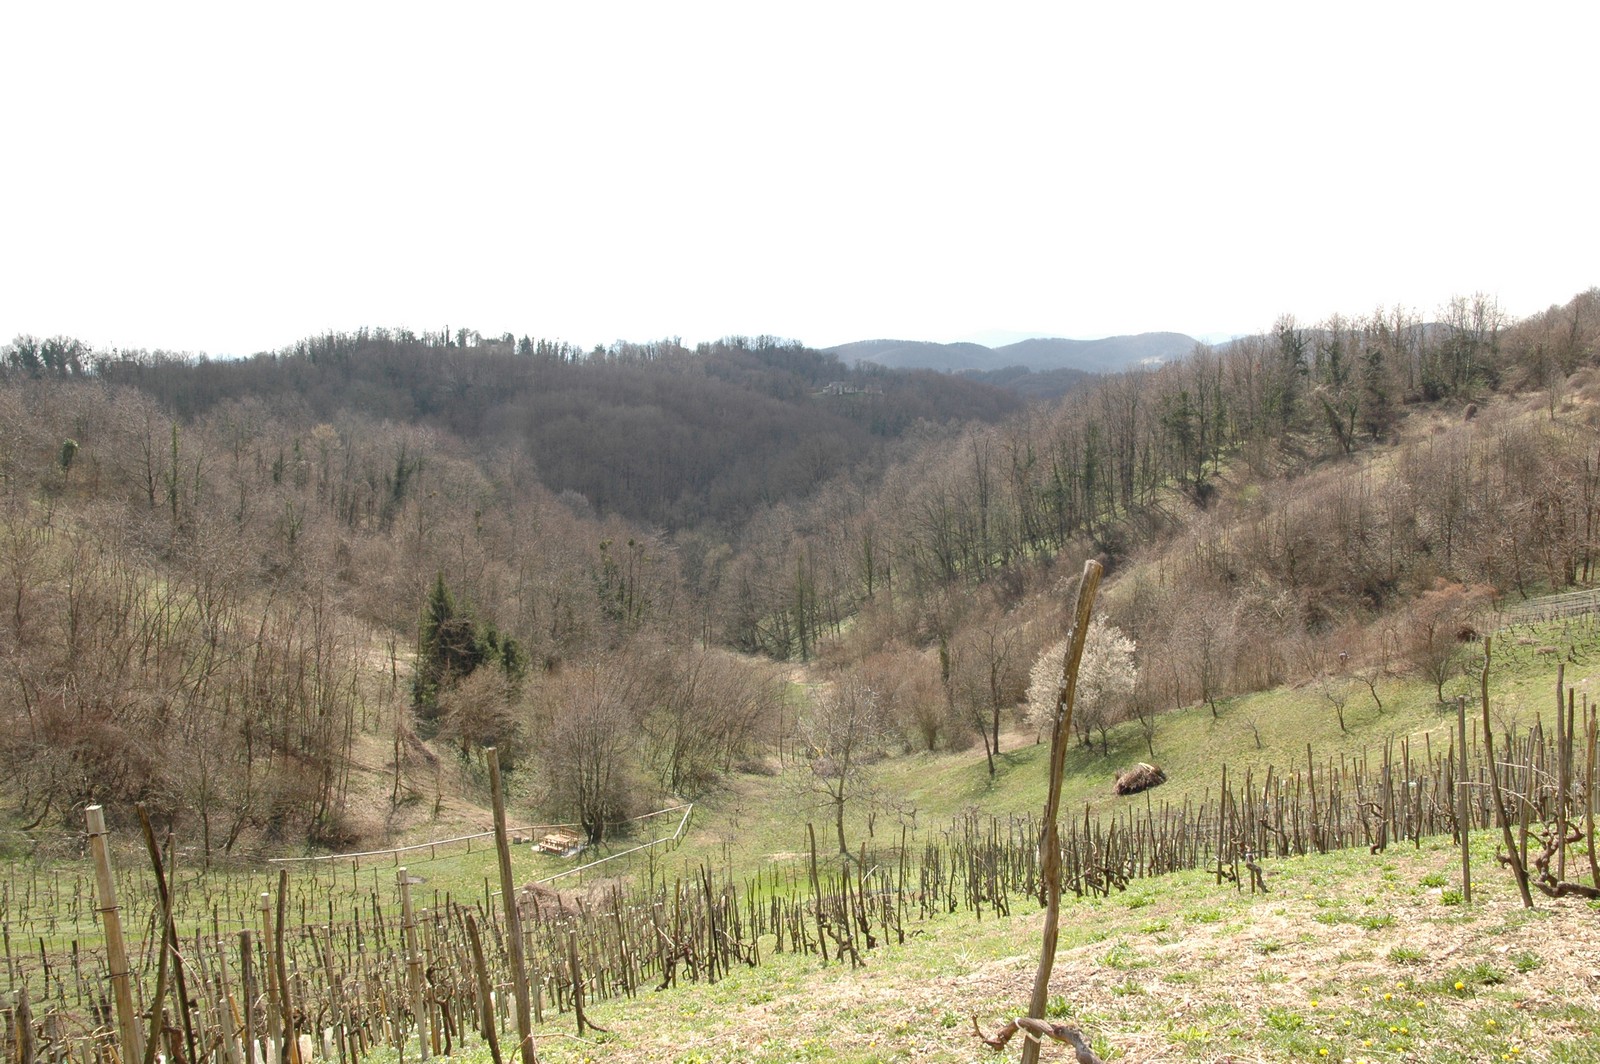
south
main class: Cropland
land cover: Vineyards
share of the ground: > 75 %
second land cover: Grassland without tree/shrub cover
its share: < 10 %
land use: Agriculture (excluding fallow land and kitchen gardens)
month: March
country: HR
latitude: 46.3400
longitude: 16.0929
